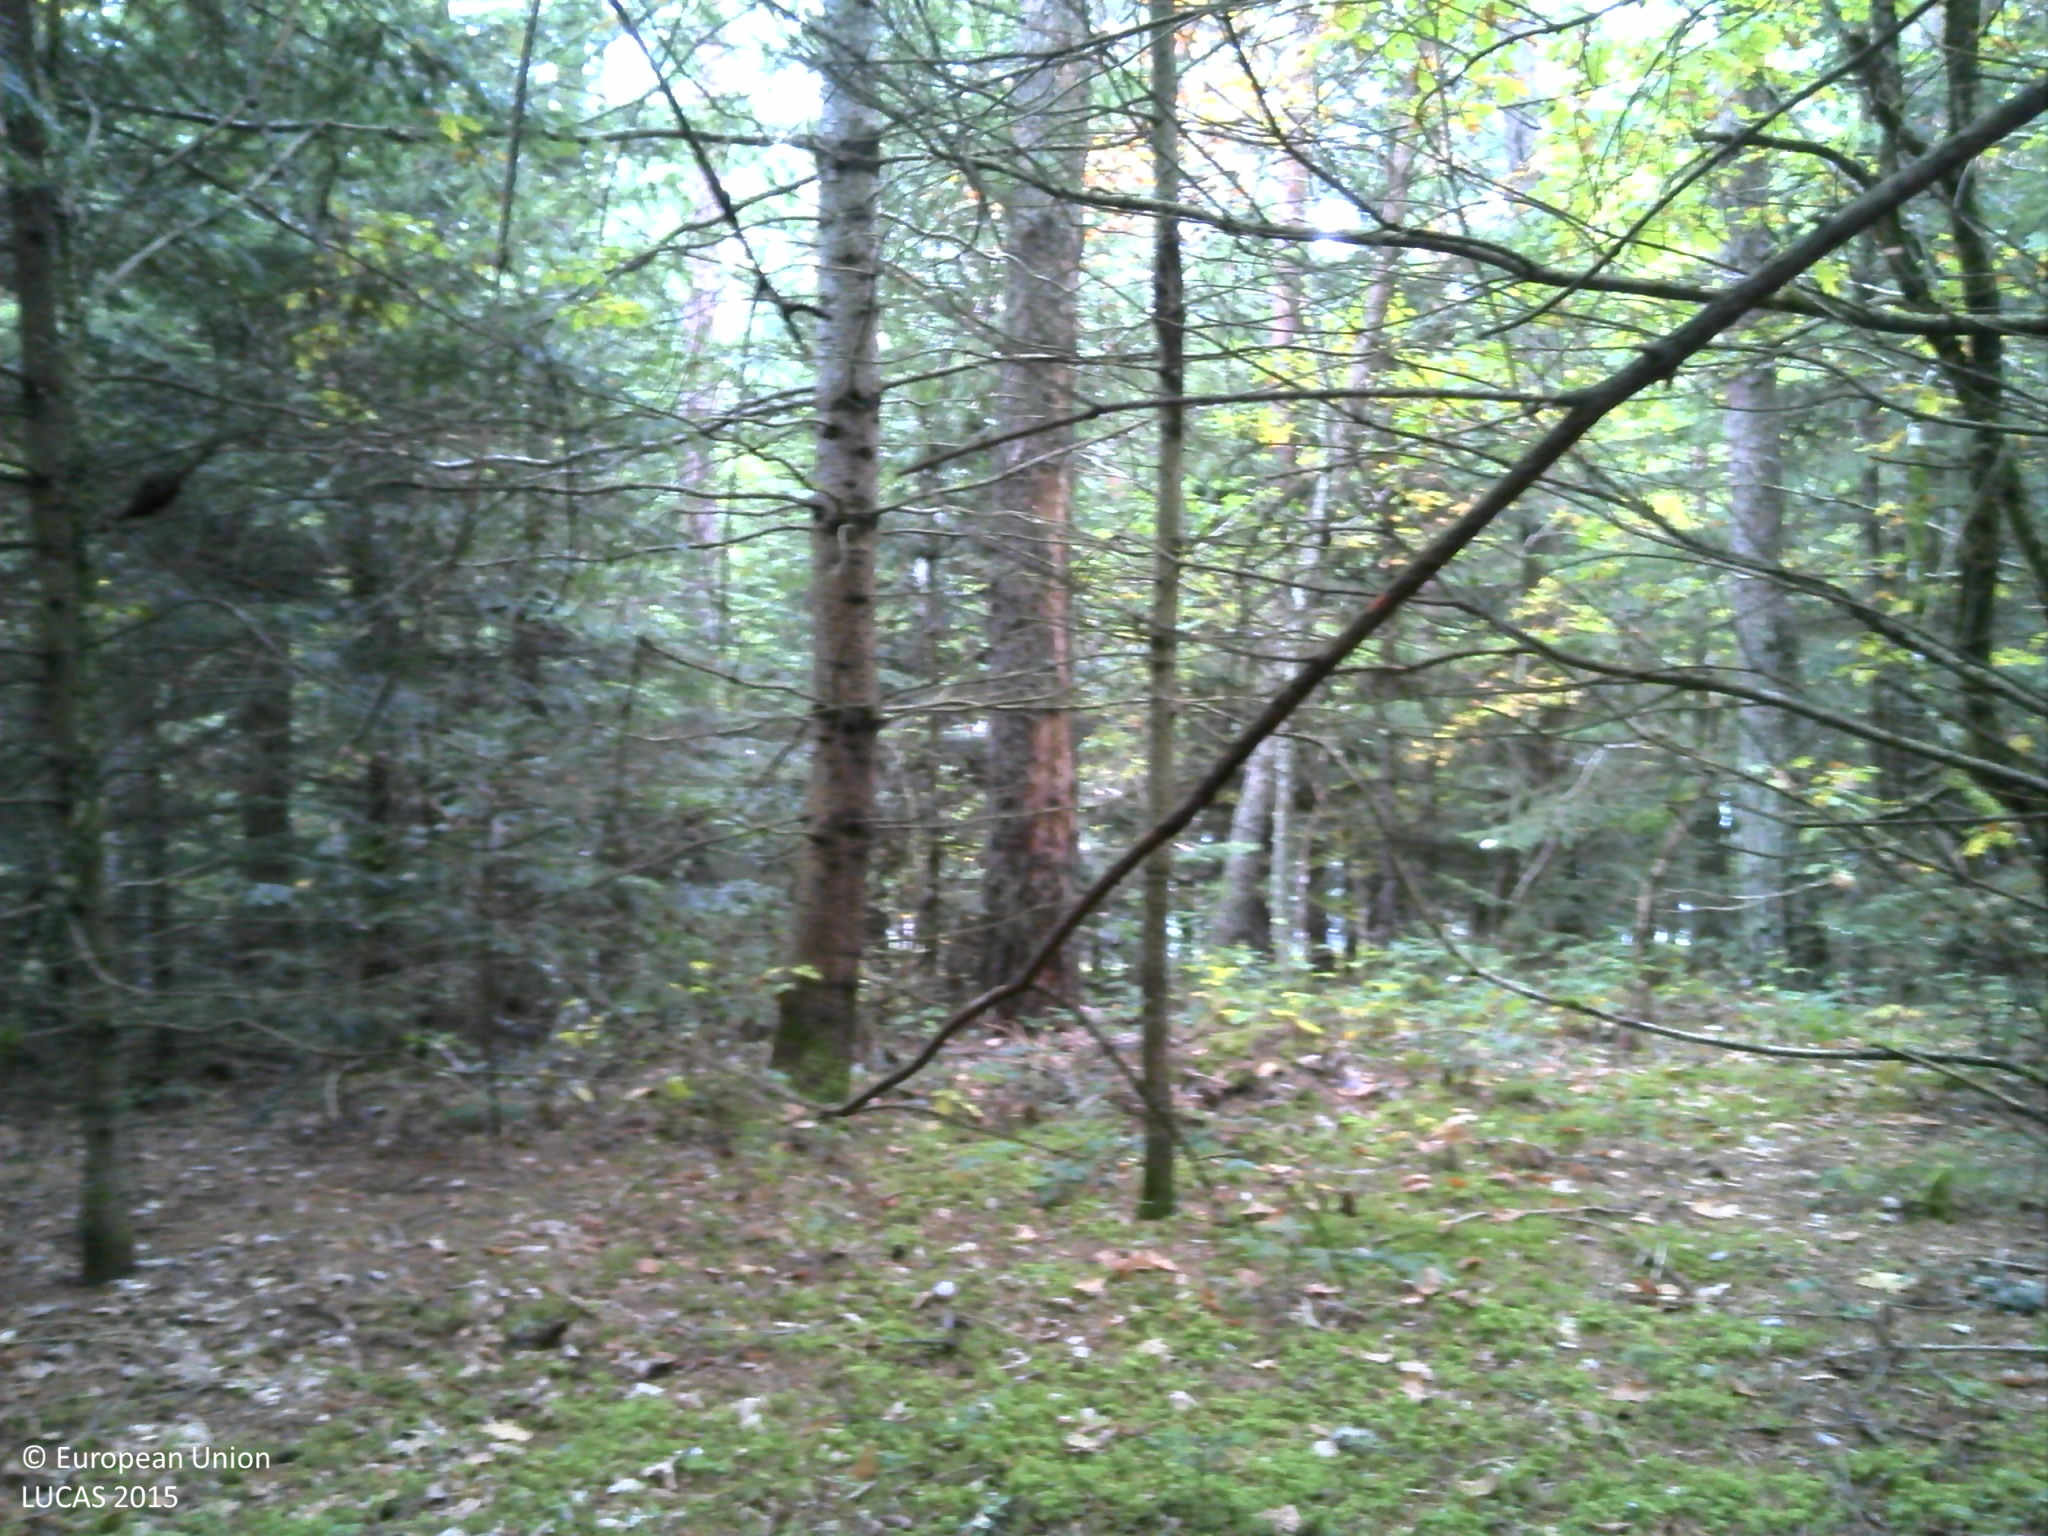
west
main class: Woodland
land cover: Other mixed woodland
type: mesophytic deciduous forest
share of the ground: > 75 %
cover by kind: coniferous forest trees 50 %, broadleaved forest trees 20 %, lichens and mosses 20 %, unconsolidated bare surface 10 %
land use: Forestry
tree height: > 5 m
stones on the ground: < 10 %
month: October
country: FR
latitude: 45.4831
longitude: 3.7719
